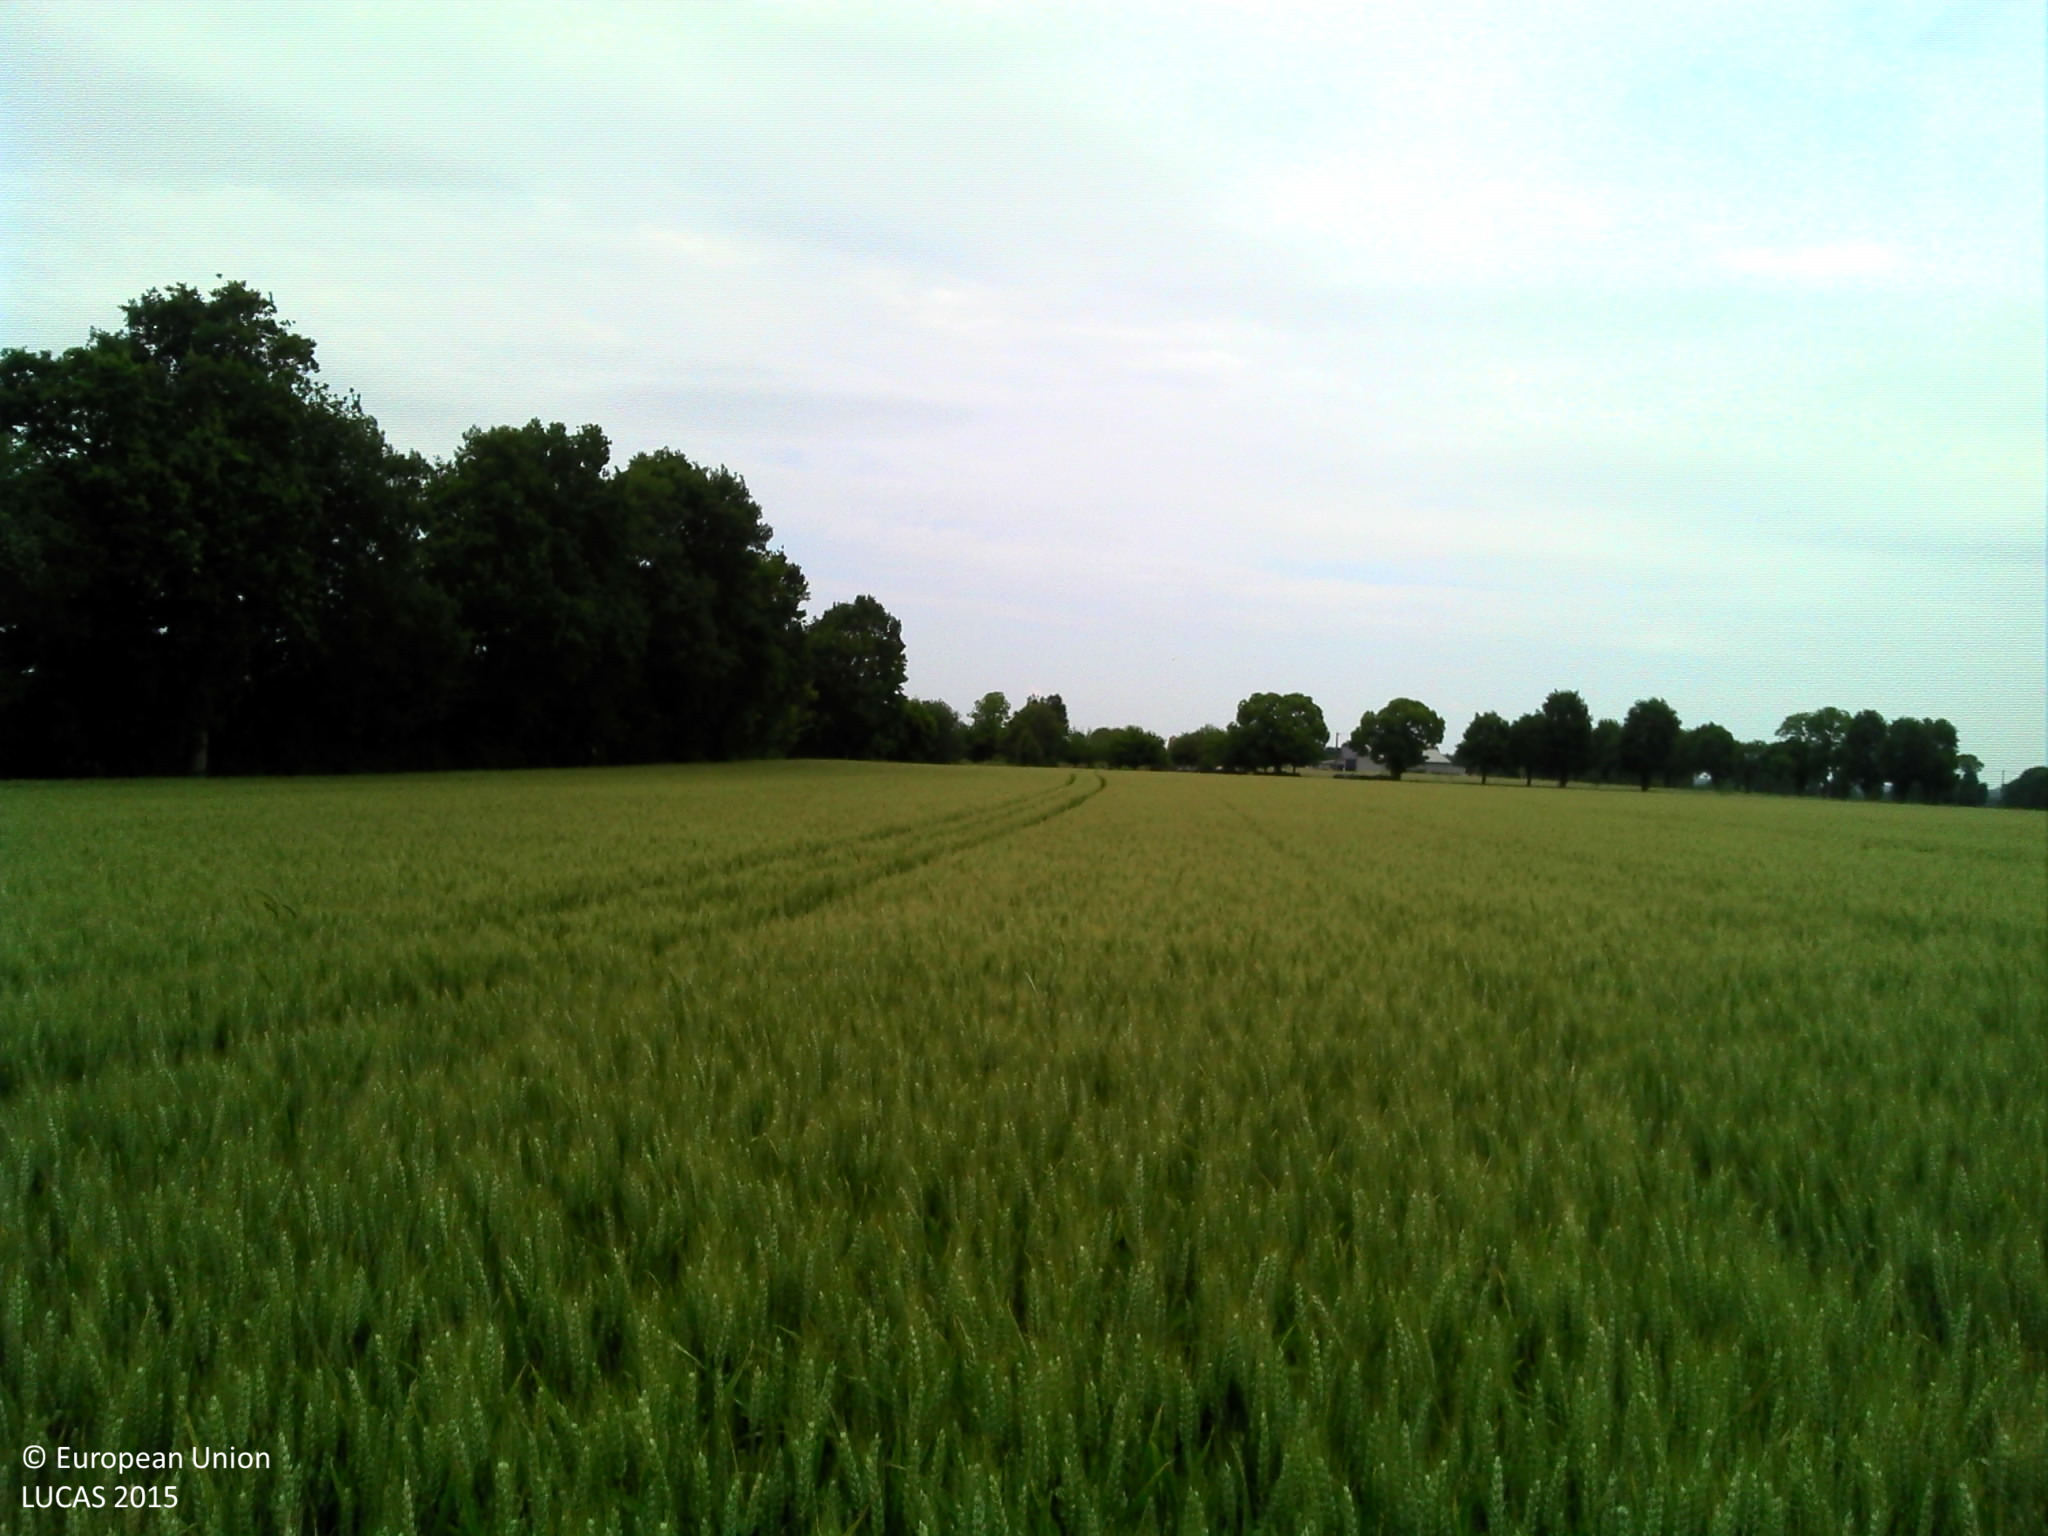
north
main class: Cropland
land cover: Common wheat
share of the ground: > 75 %
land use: Agriculture (excluding fallow land and kitchen gardens)
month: June
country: FR
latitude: 48.1914
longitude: -1.9303
